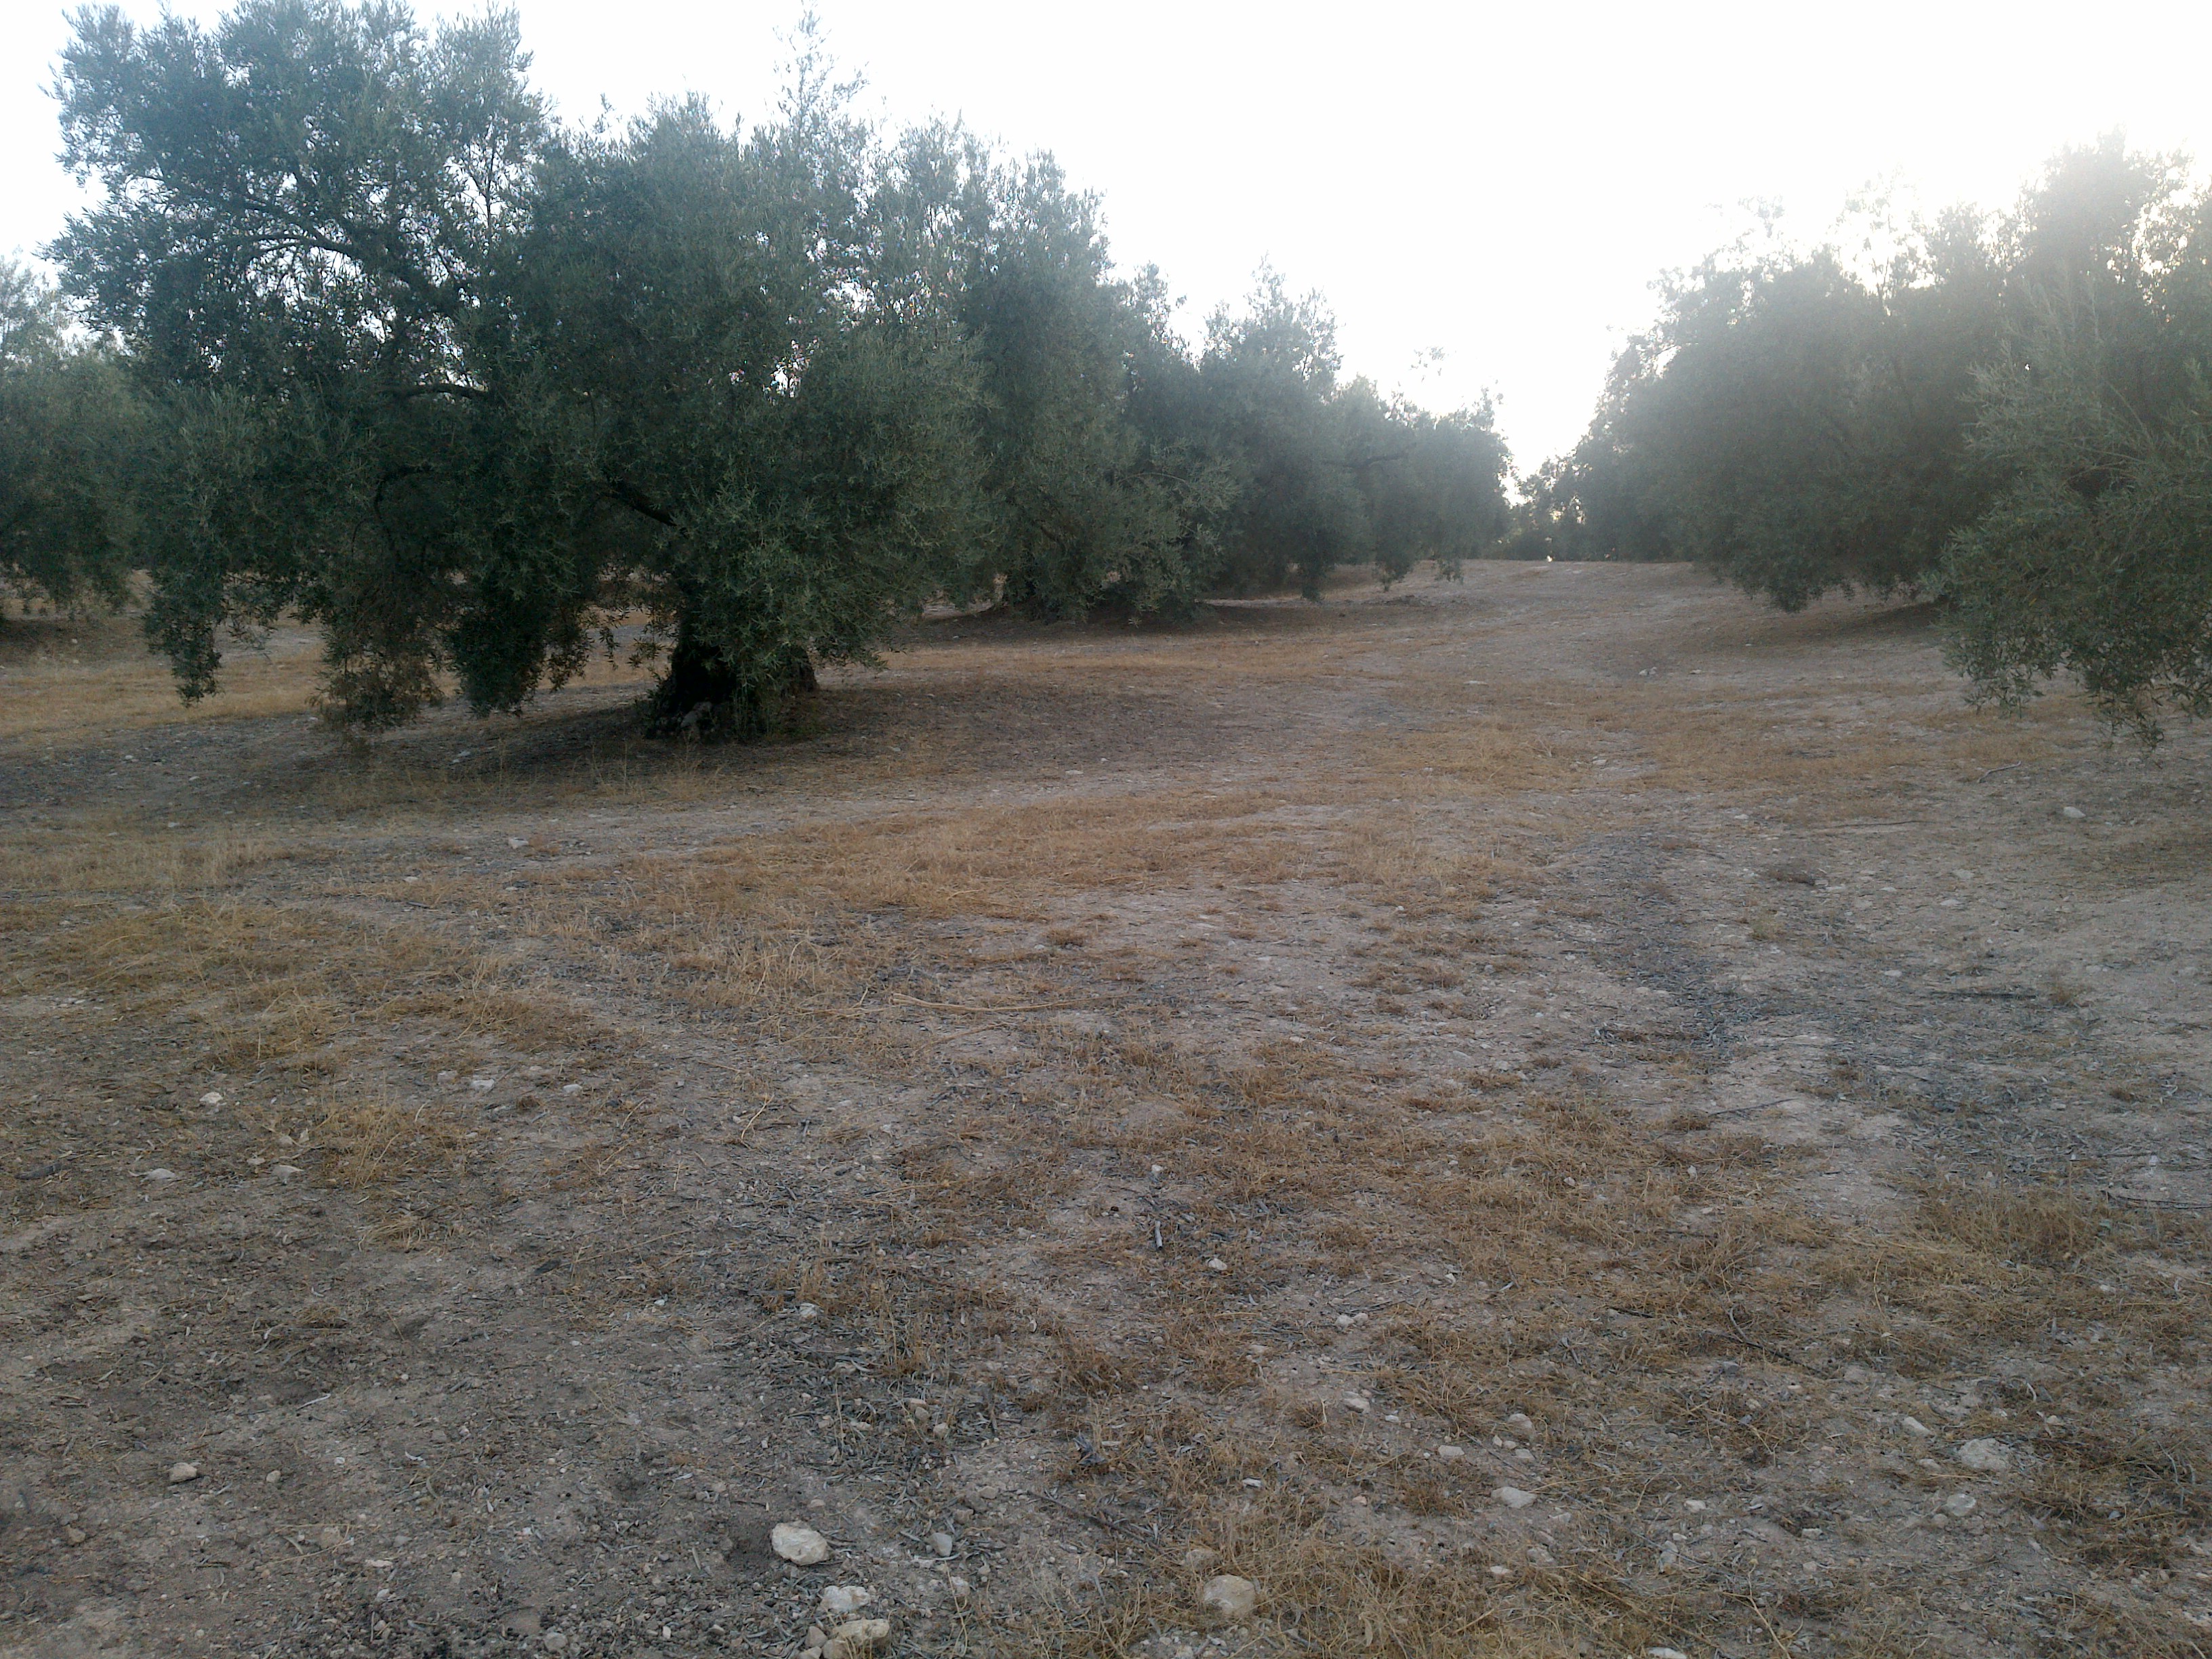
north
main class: Cropland
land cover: Olive groves
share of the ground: 50 - 75 %
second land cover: Spontaneously vegetated surfaces
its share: 10 - 25 %
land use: Agriculture (excluding fallow land and kitchen gardens)
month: July
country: ES
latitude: 37.3807
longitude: -4.4004
